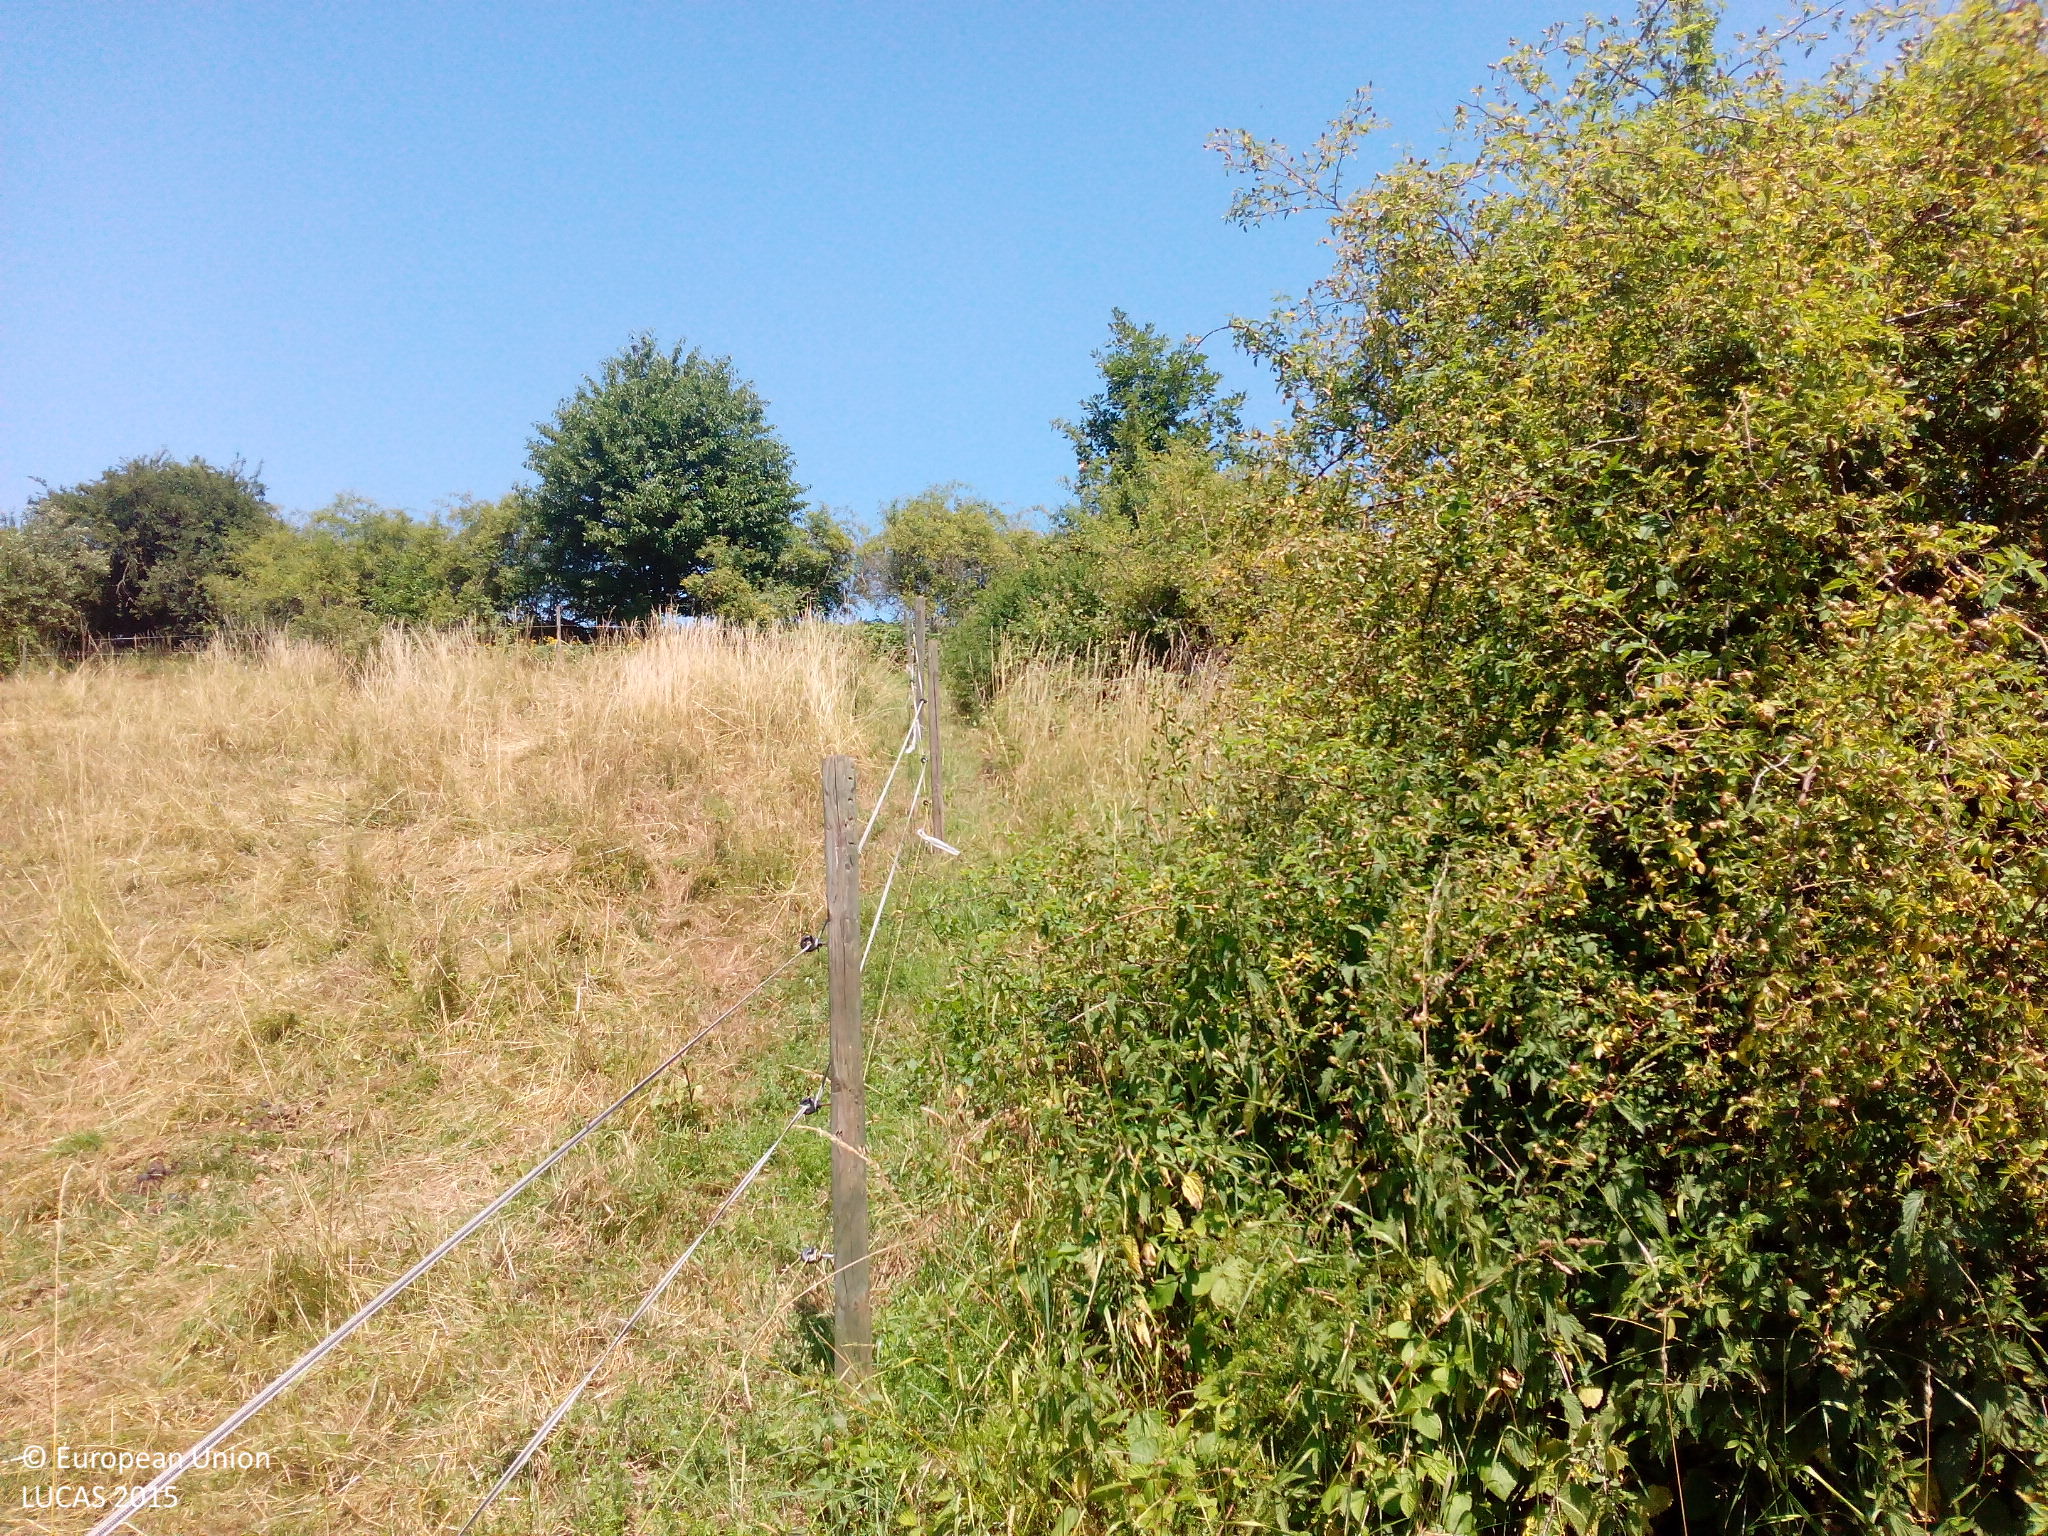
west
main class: Grassland
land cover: Grassland with sparse tree/shrub cover
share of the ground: > 75 %
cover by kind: herbaceous plants 80 %, unconsolidated bare surface 10 %, broadleaved forest trees 5 %, shrubs 5 %
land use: Agriculture (excluding fallow land and kitchen gardens)
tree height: < 5 m
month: July
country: DE
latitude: 49.5823
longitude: 7.5523
